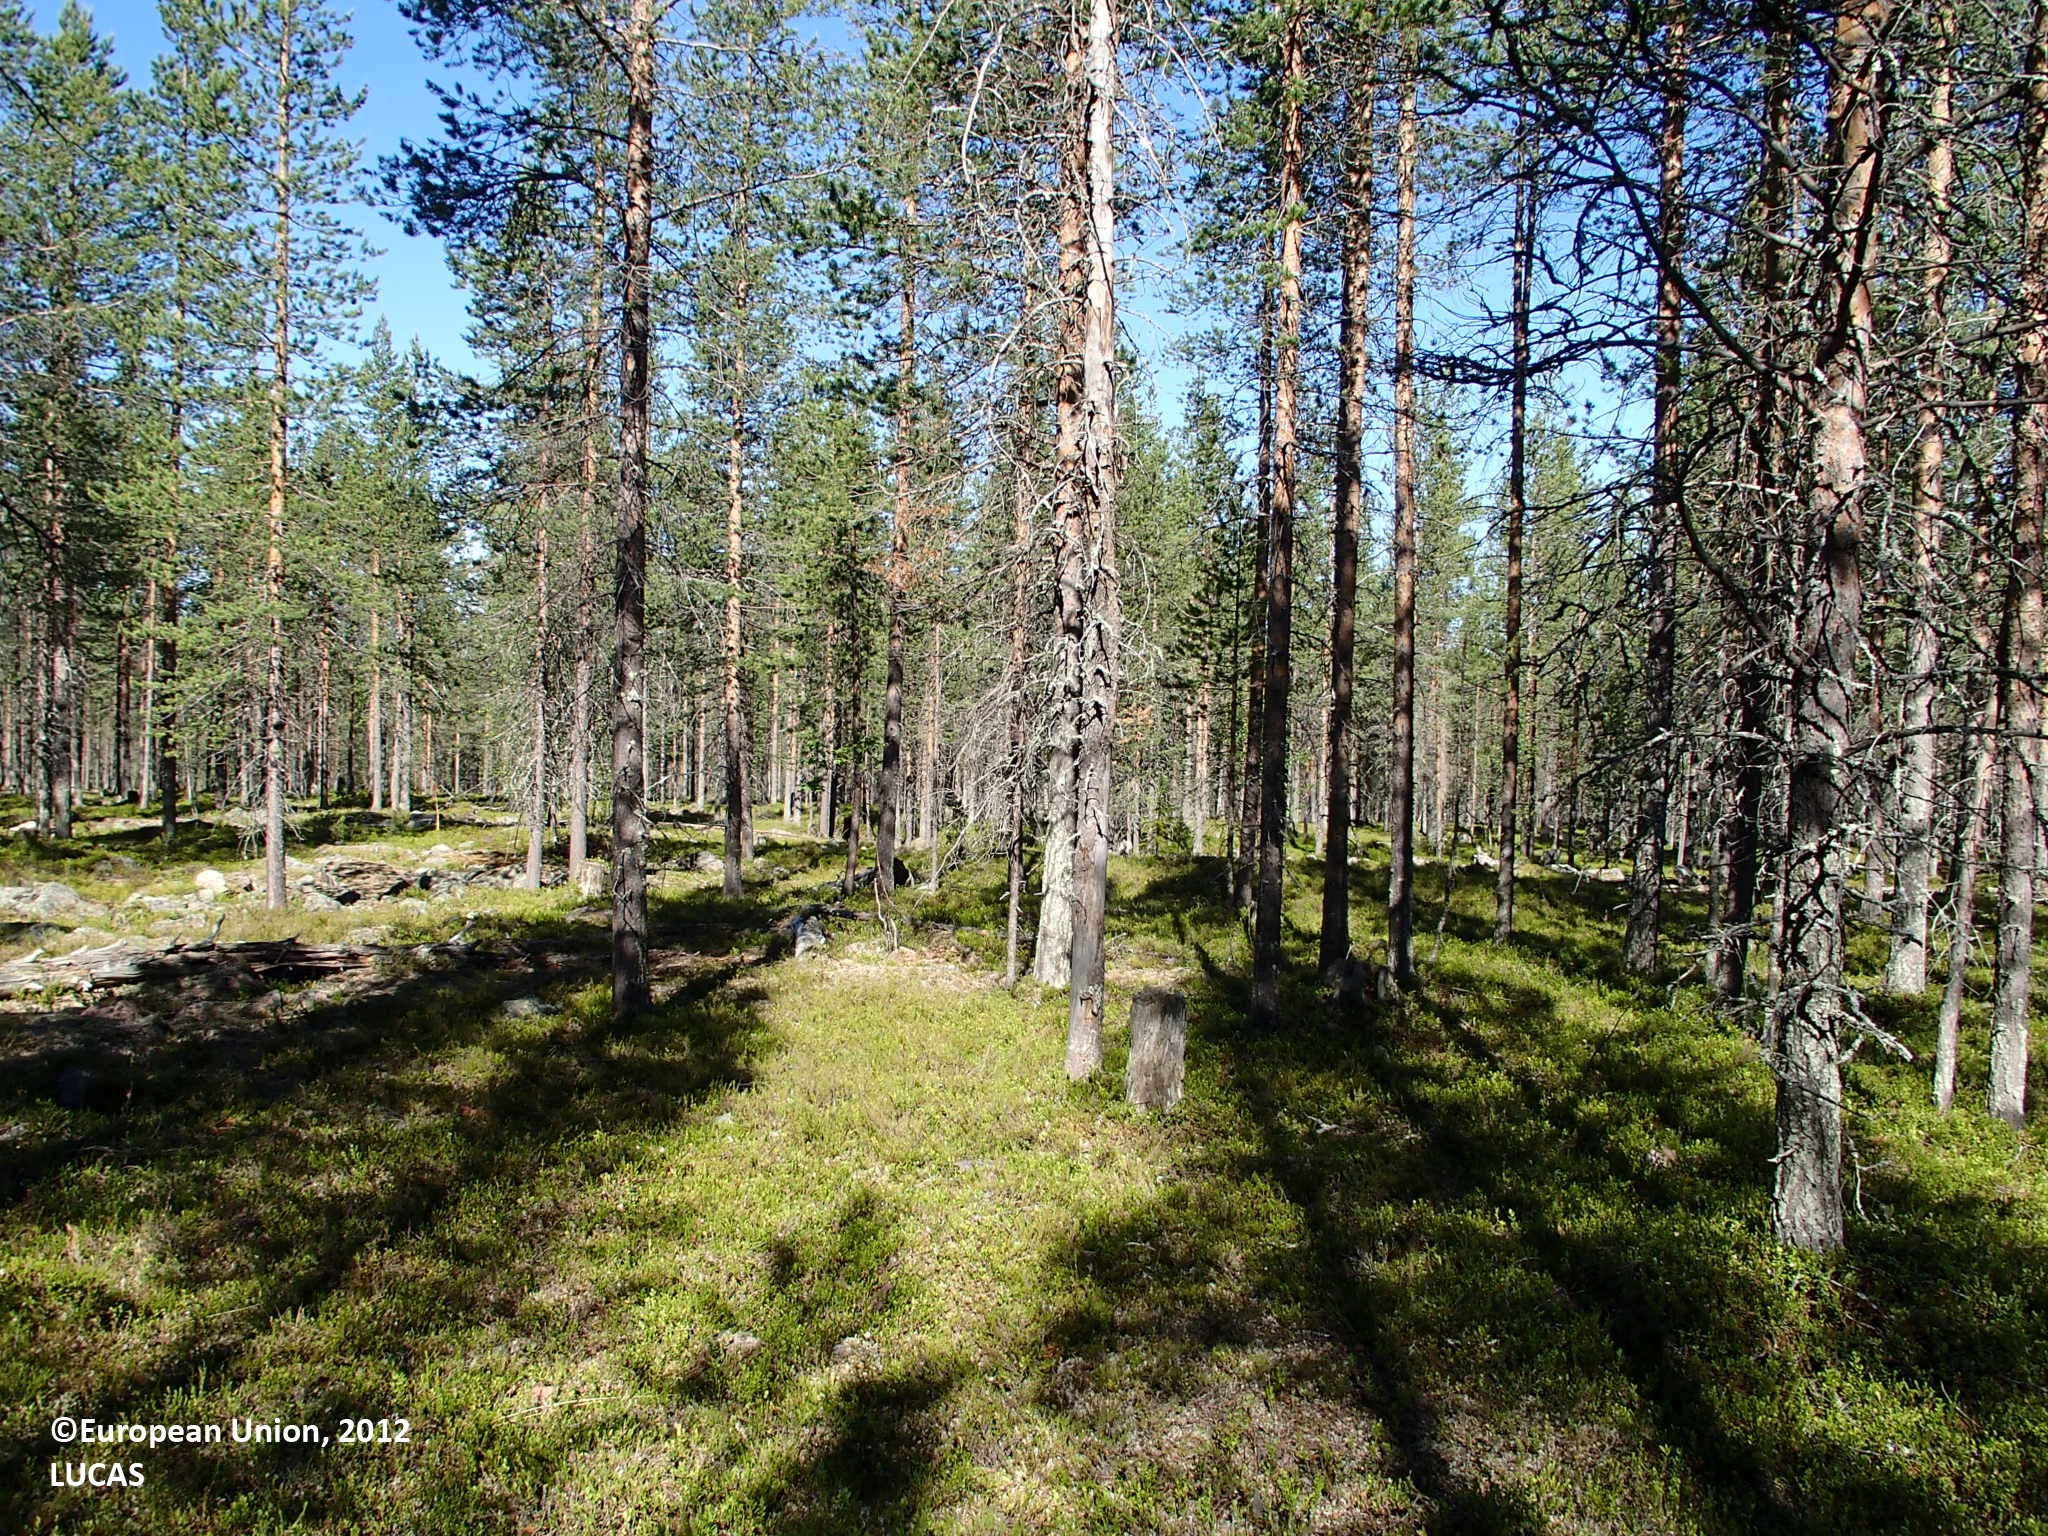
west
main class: Woodland
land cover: Pine dominated coniferous woodland
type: boreal forest
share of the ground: 25 - 50 %
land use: Forestry
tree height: > 5 m
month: July
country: FI
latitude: 67.2027
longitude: 26.7099
